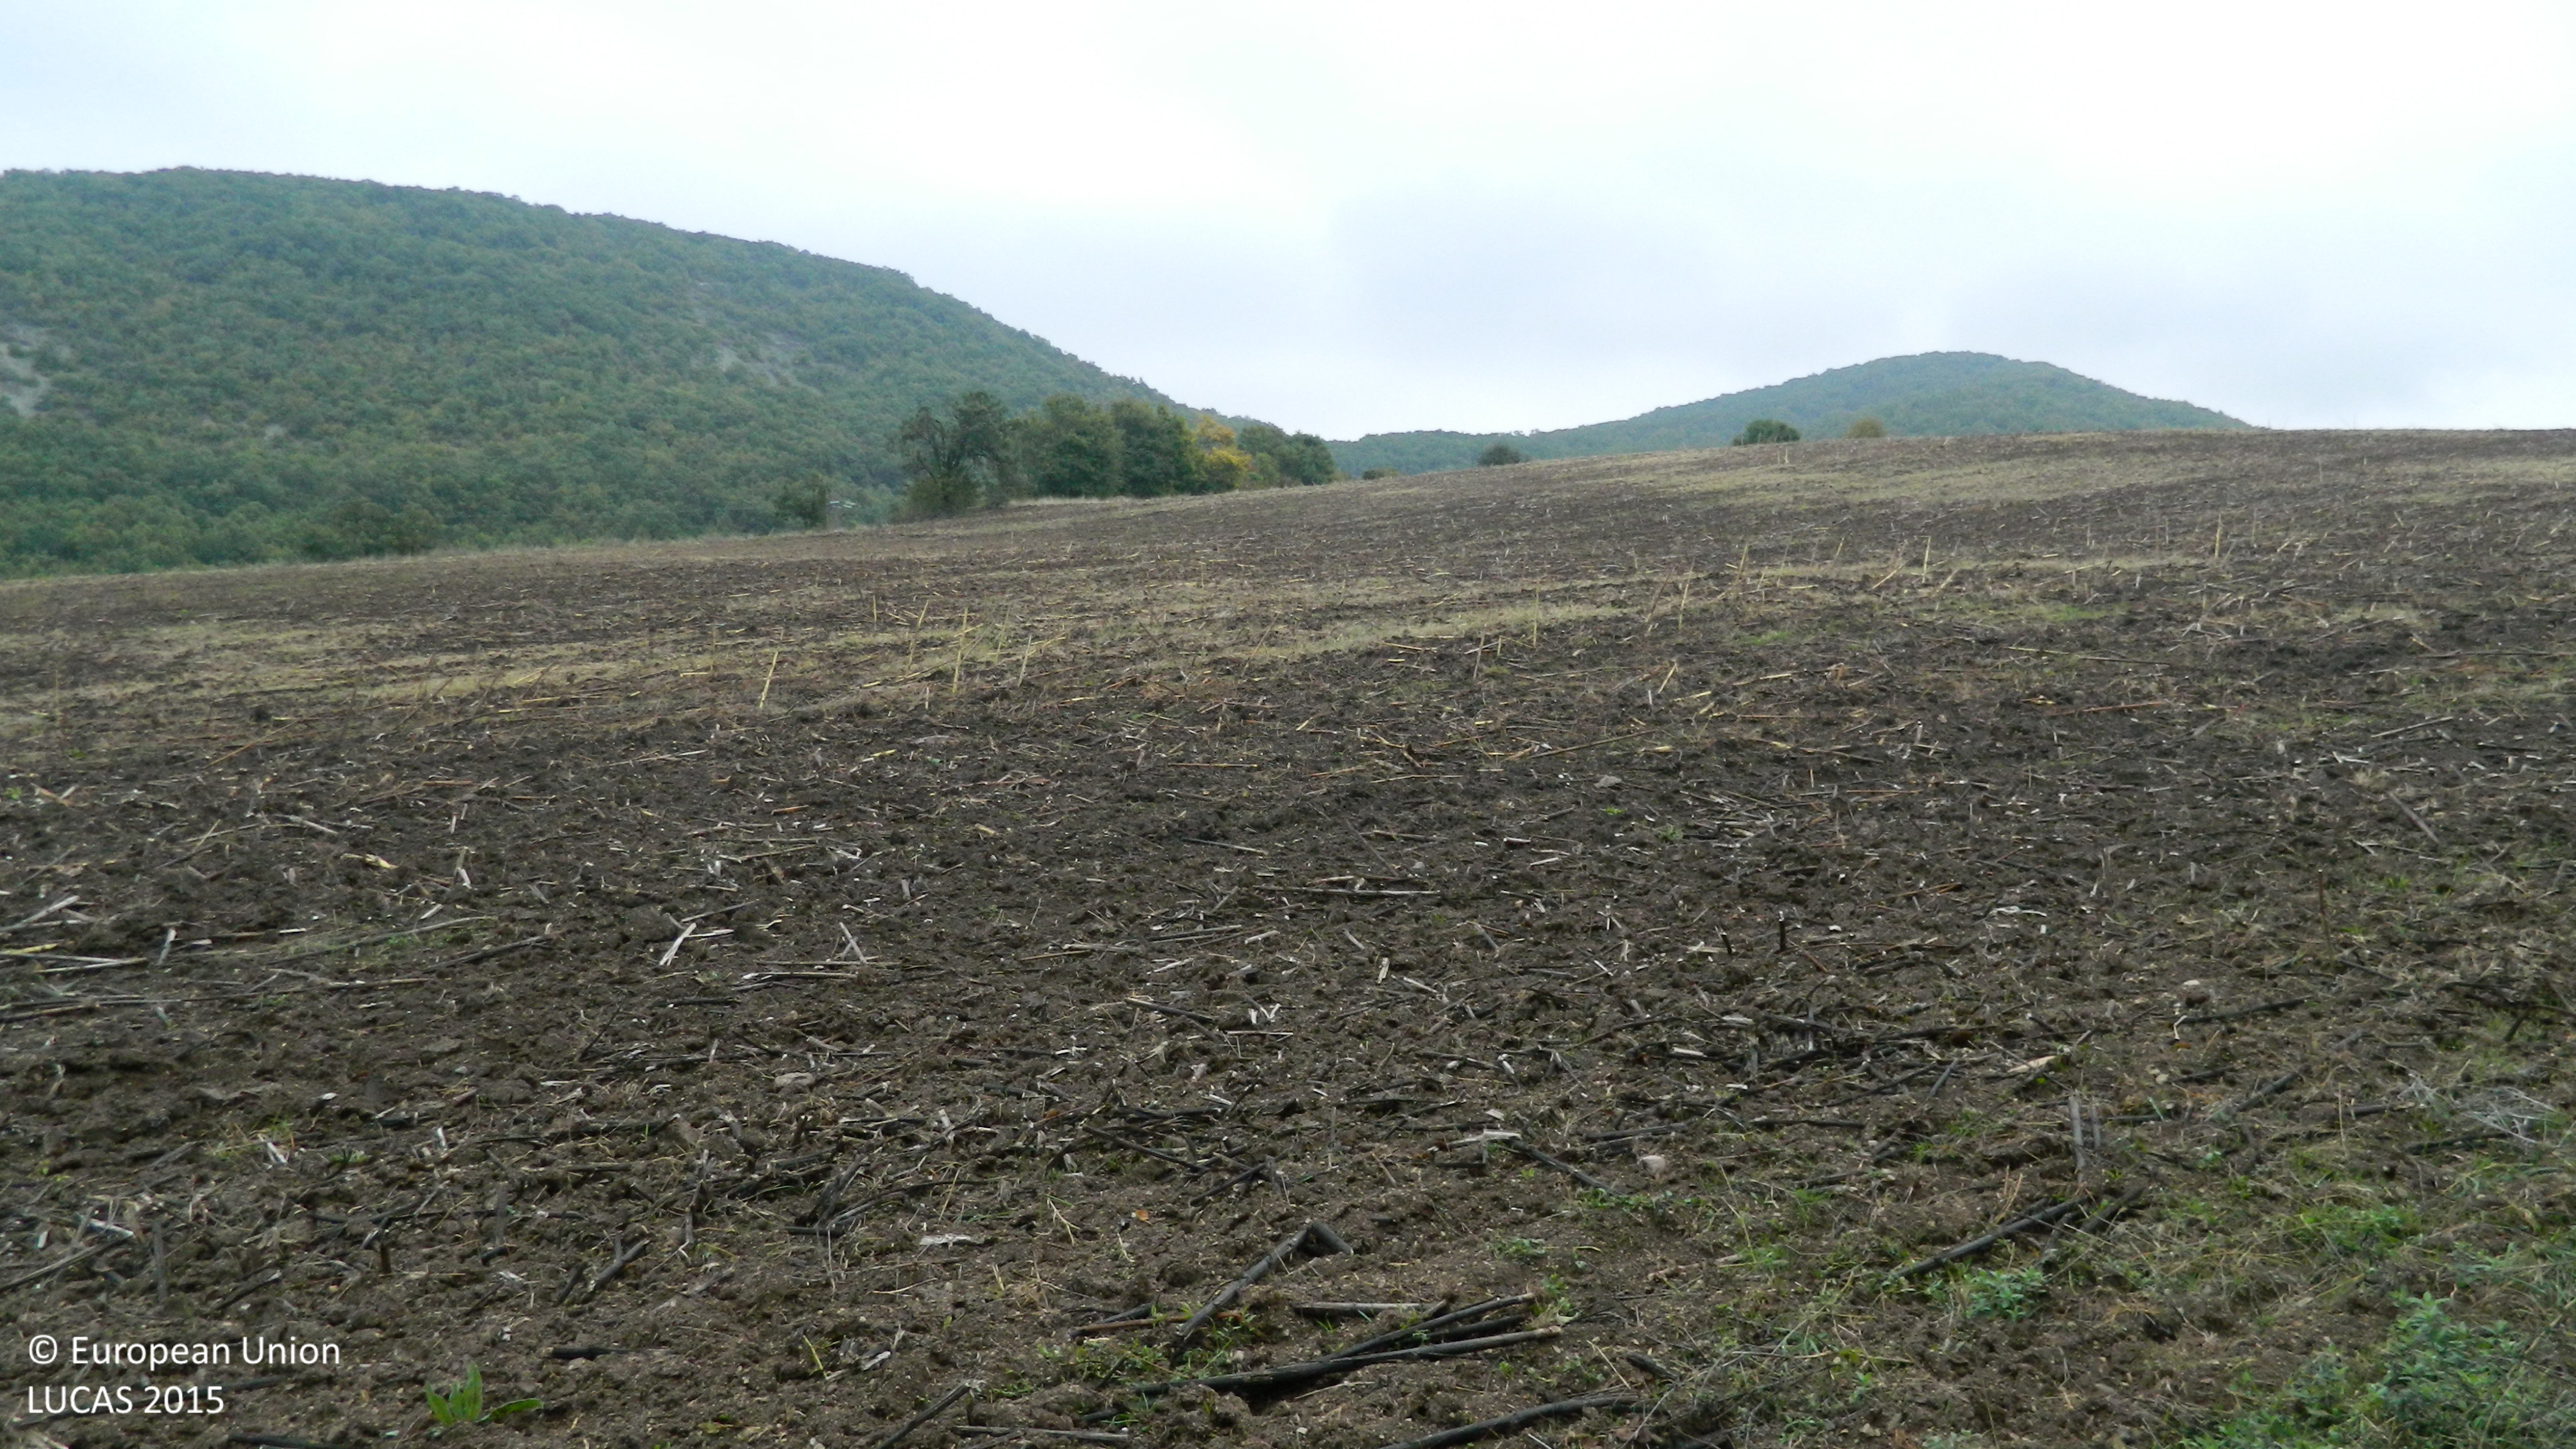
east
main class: Shrubland
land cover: Shrubland with sparse tree cover
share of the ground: > 75 %
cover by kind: shrubs 90 %, broadleaved forest trees 5 %, herbaceous plants 5 %
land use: Semi-natural and natural areas not in use
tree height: > 5 m
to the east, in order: Shrubland with sparse tree cover; Grass margins; Sunflower; Grassland with sparse tree/shrub cover; Broadleaved woodland; Rivers and streams; Broadleaved woodland
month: October
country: BG
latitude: 41.7979
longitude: 25.4038
